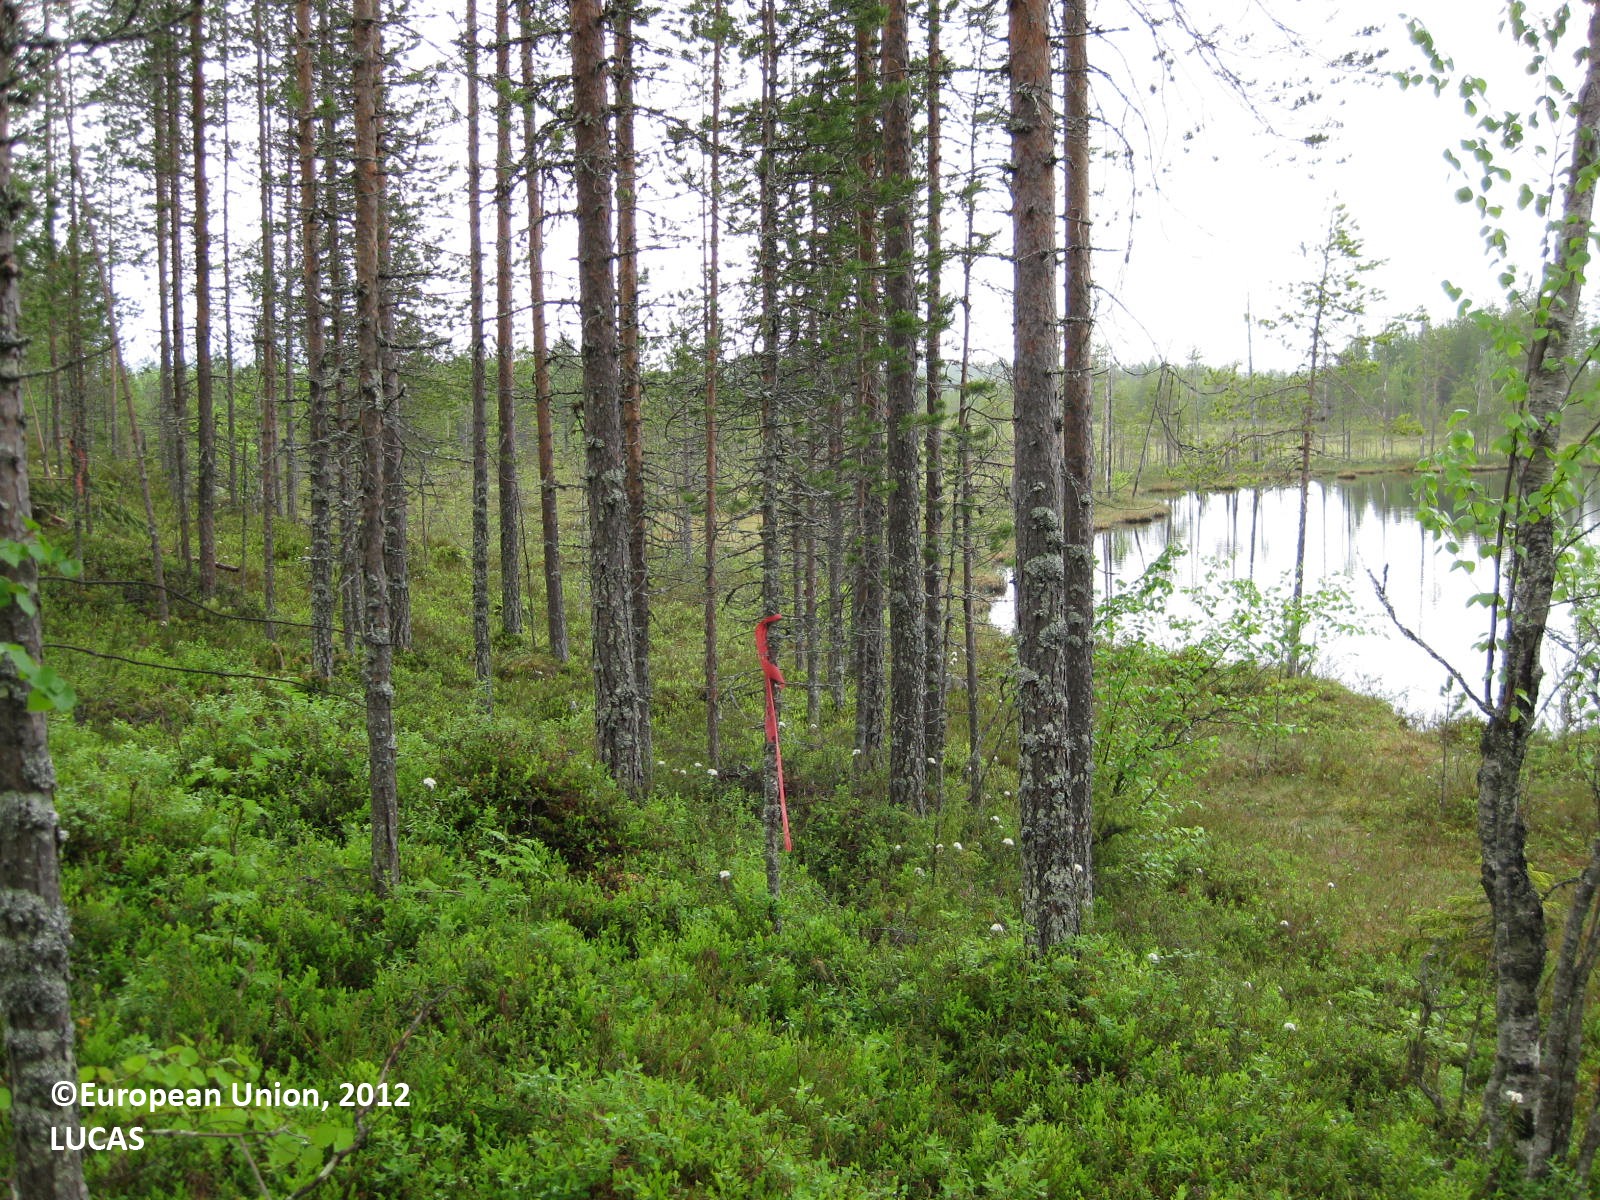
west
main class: Woodland
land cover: Pine dominated mixed woodland
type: boreal forest
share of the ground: 50 - 75 %
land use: Forestry
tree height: > 5 m
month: June
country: FI
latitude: 65.1454
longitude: 29.2790
